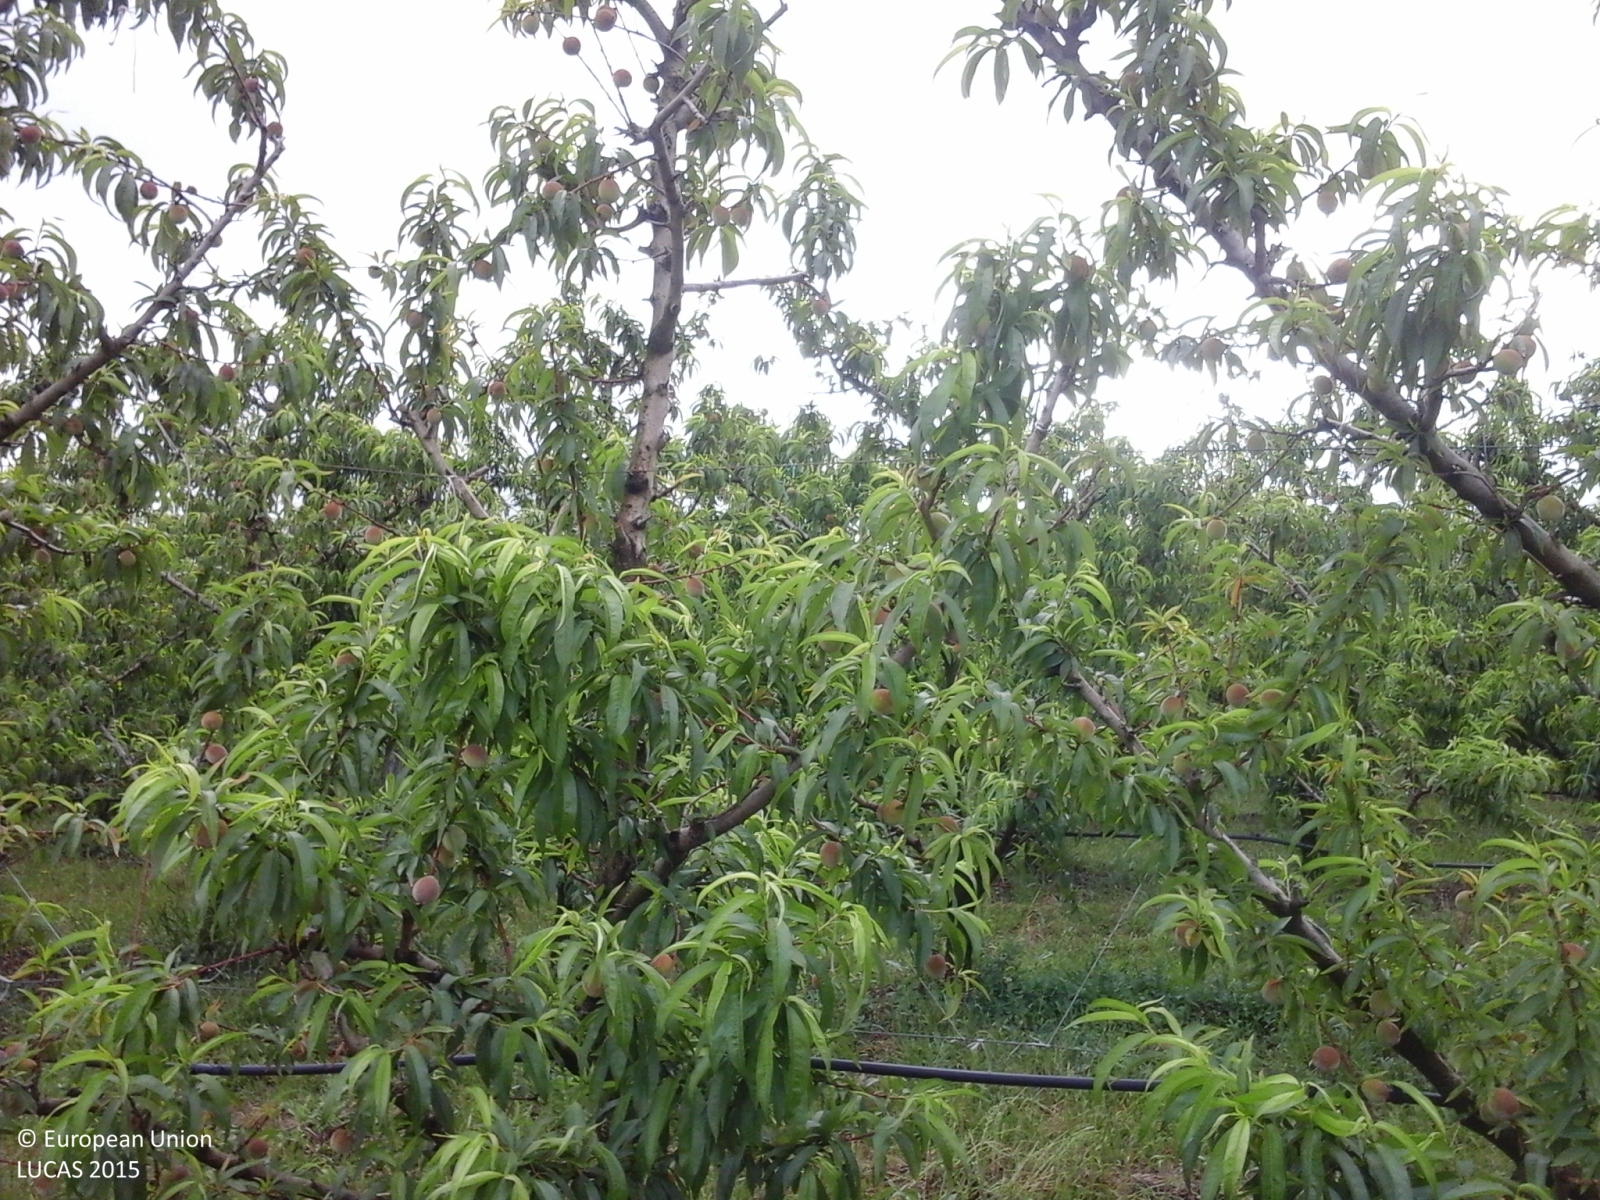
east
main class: Cropland
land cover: Mixed cereals for fodder
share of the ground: > 75 %
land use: Agriculture (excluding fallow land and kitchen gardens)
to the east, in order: Mixed cereals for fodder; Spontaneously vegetated surfaces; Other fruit trees and berries; Oats; Olive groves; Oats; Olive groves; Oats; Olive groves; Oats; Lucerne; Electric lines; Fences; Grass margins; Artificial constructions in urban areas
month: May
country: IT
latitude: 40.5869
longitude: 15.1183
